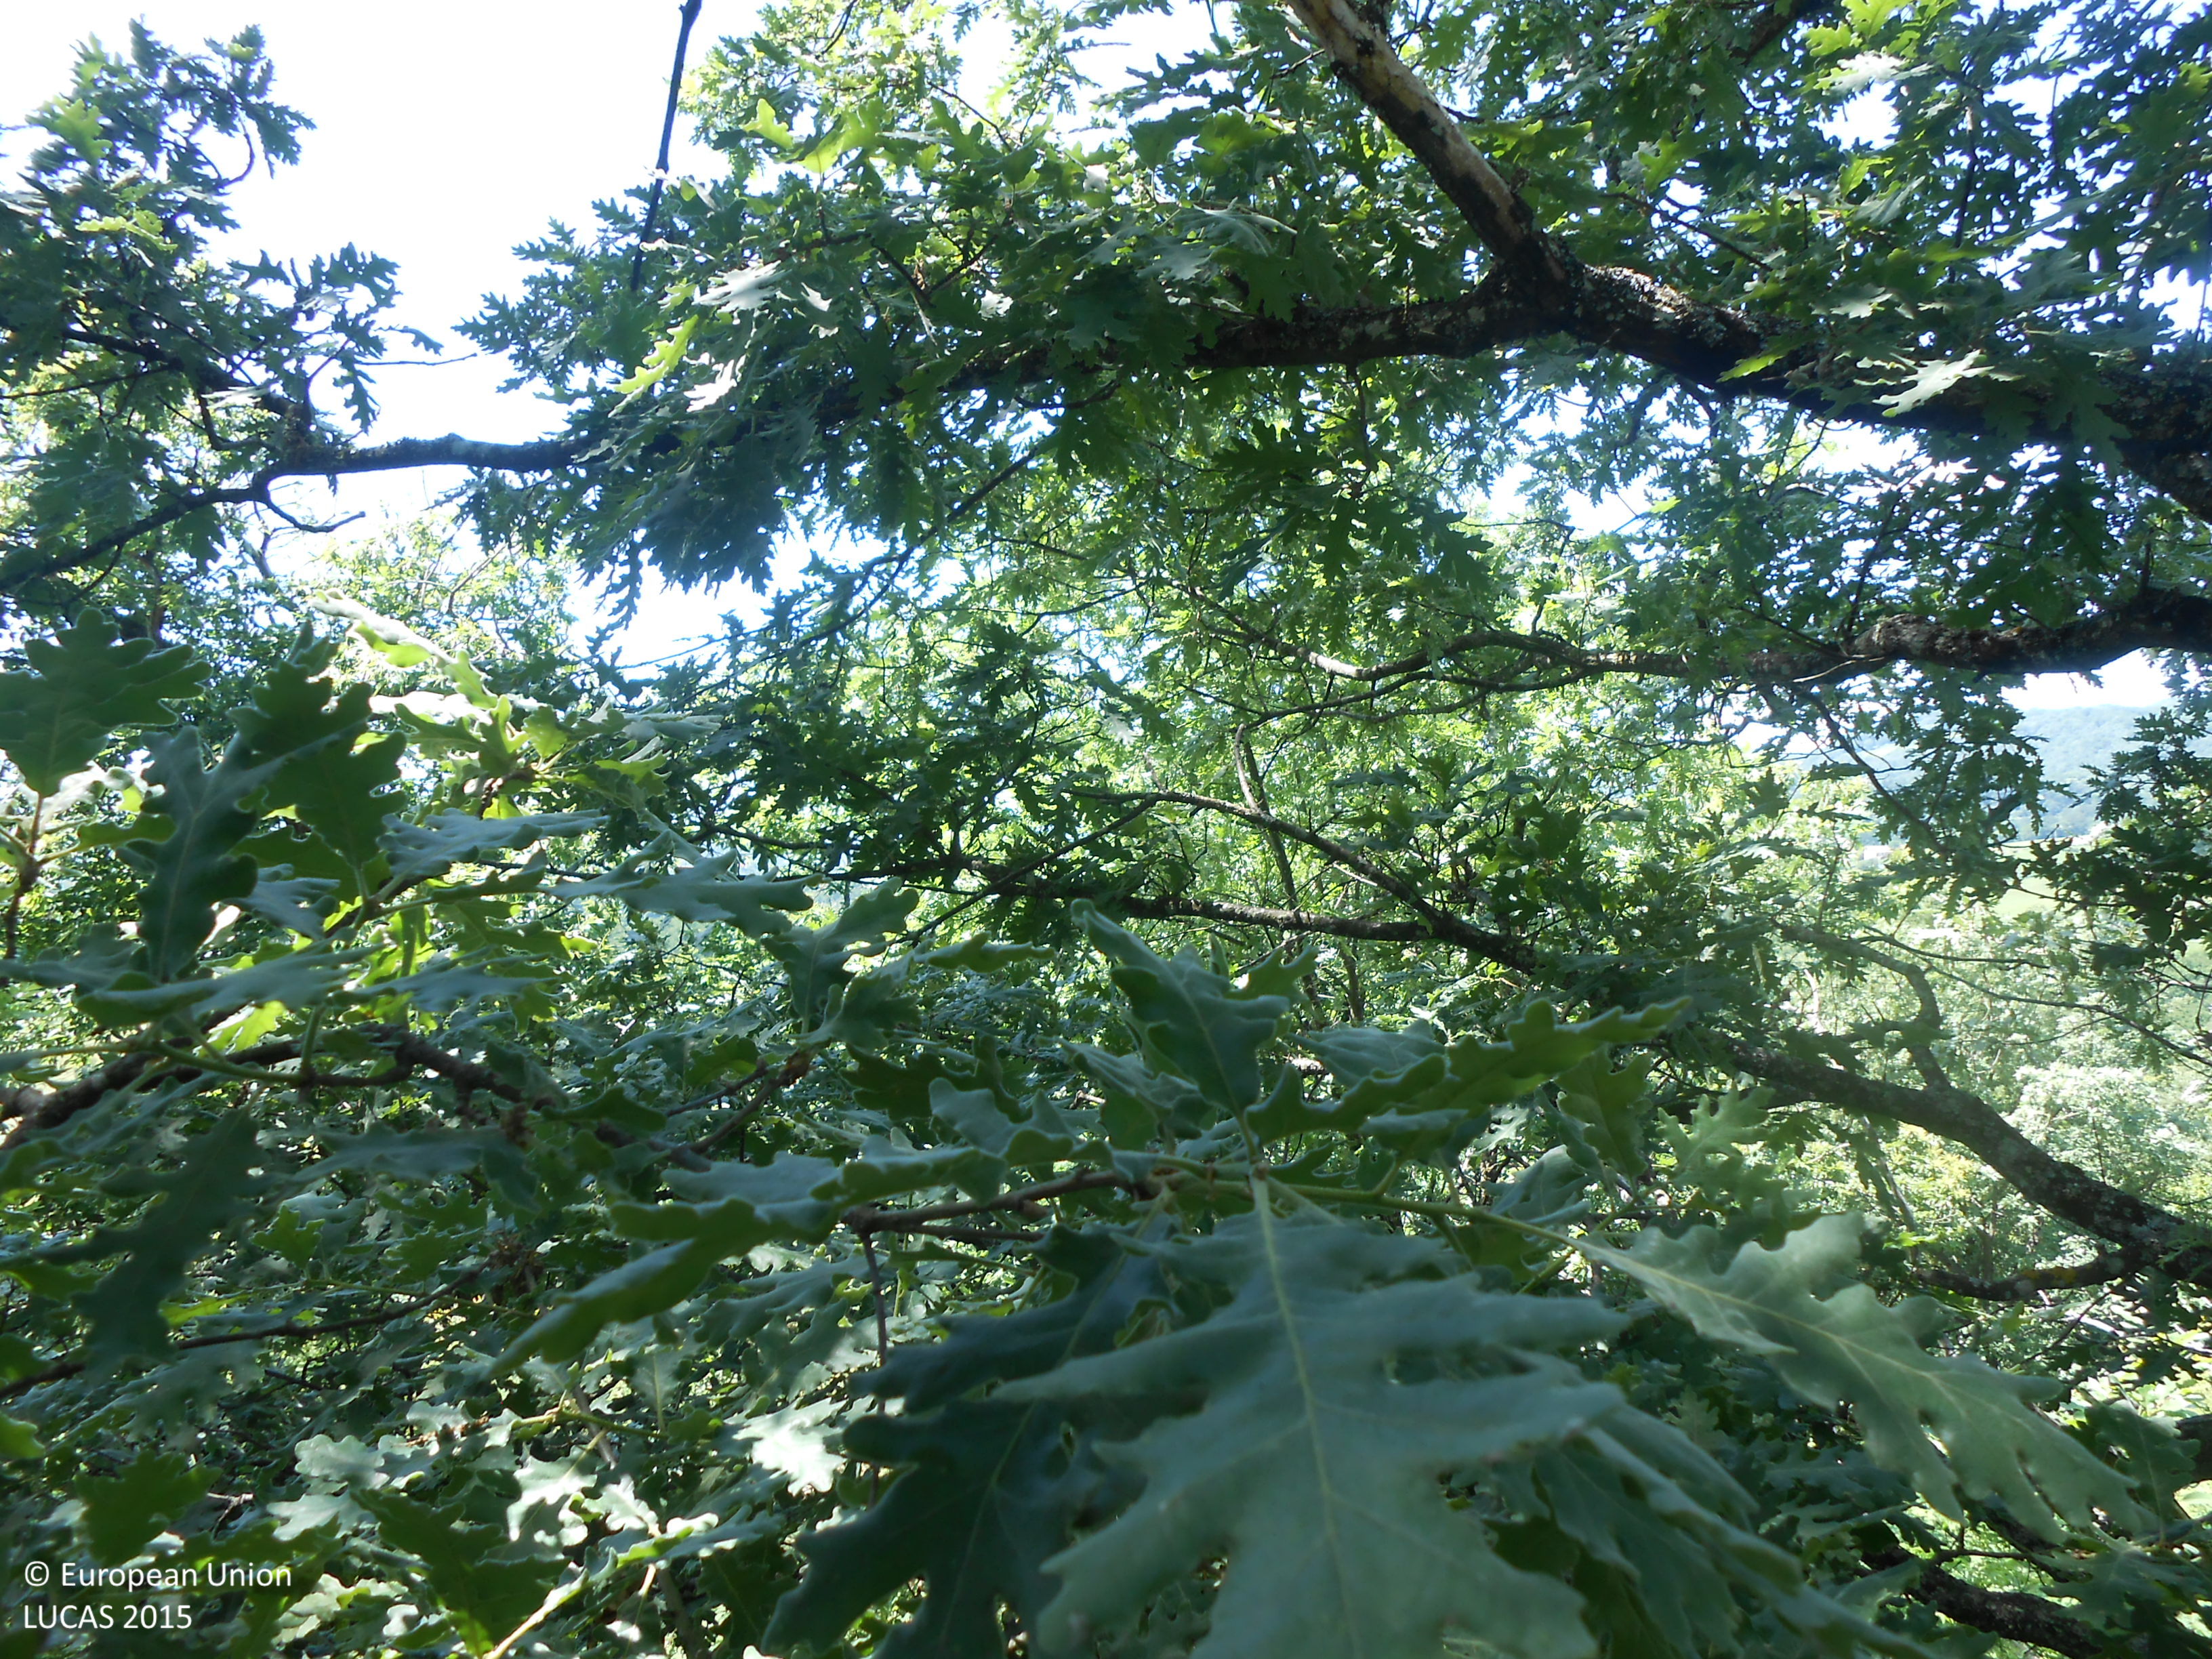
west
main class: Woodland
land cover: Broadleaved woodland
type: acidophilous oak and oak-birch forest
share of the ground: > 75 %
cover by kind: broadleaved forest trees 100 %
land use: Forestry
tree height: > 5 m
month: June
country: ES
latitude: 43.0112
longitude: -1.7093
